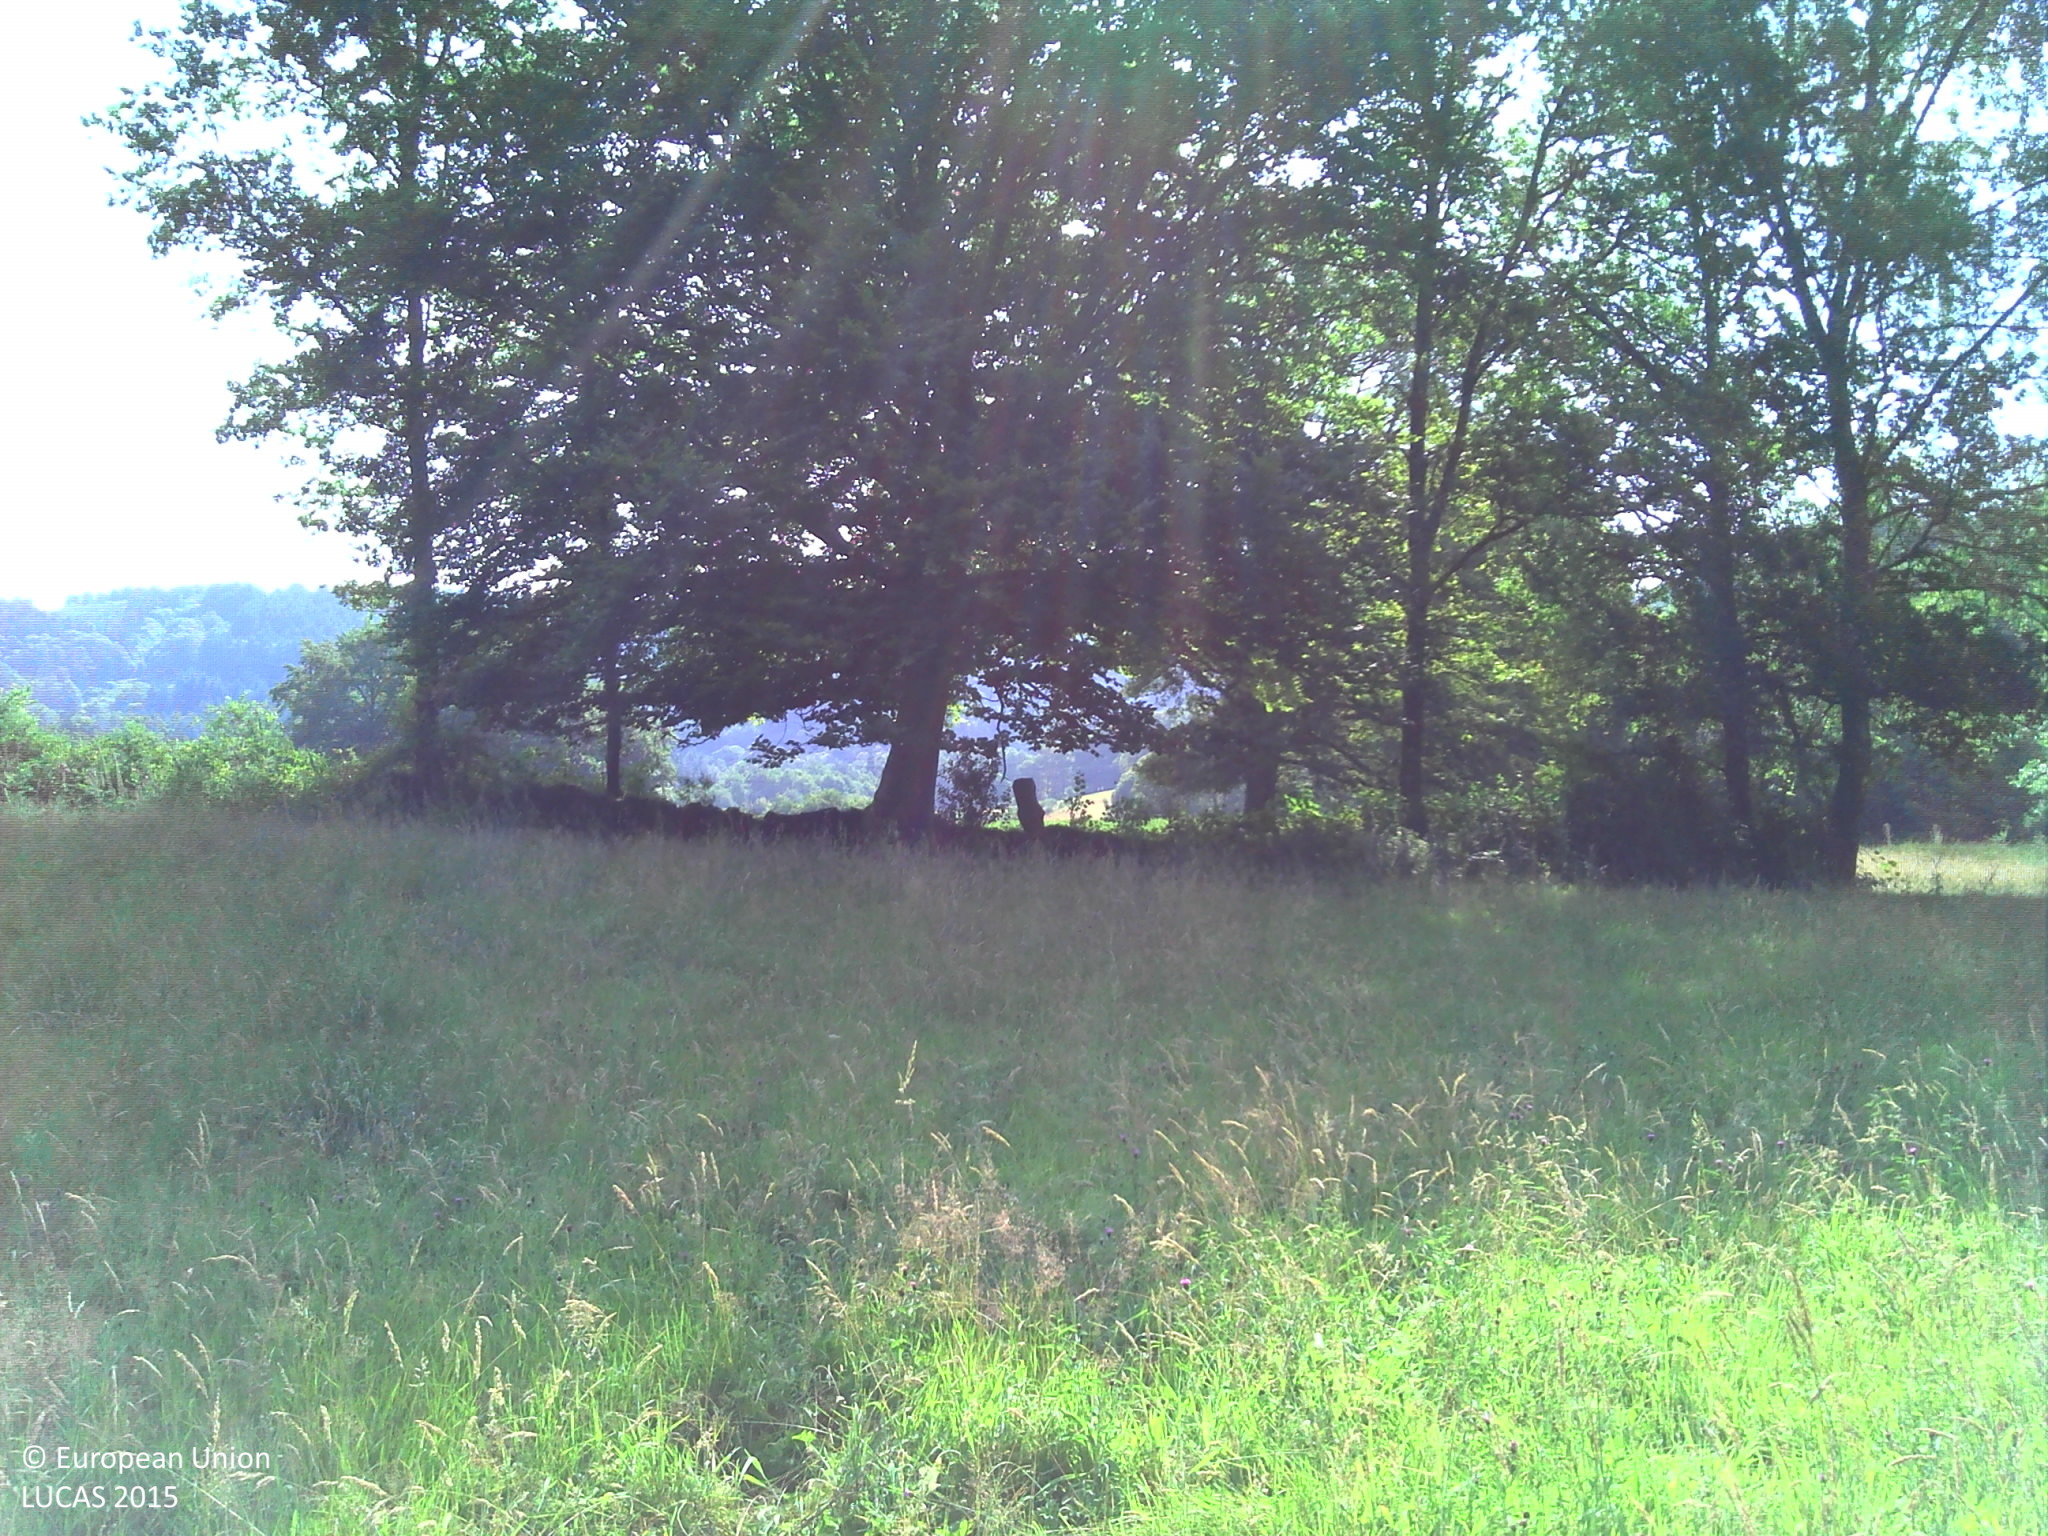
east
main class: Grassland
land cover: Grassland without tree/shrub cover
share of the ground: > 75 %
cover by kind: herbaceous plants 100 %
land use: Agriculture (excluding fallow land and kitchen gardens)
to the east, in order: Grassland without tree/shrub cover; Lines of trees; Fences; Clovers; Fences; Spontaneously vegetated surfaces; Rivers and streams; Managed hedges; Grassland with sparse tree/shrub cover
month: July
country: FR
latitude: 45.8005
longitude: 1.7982
